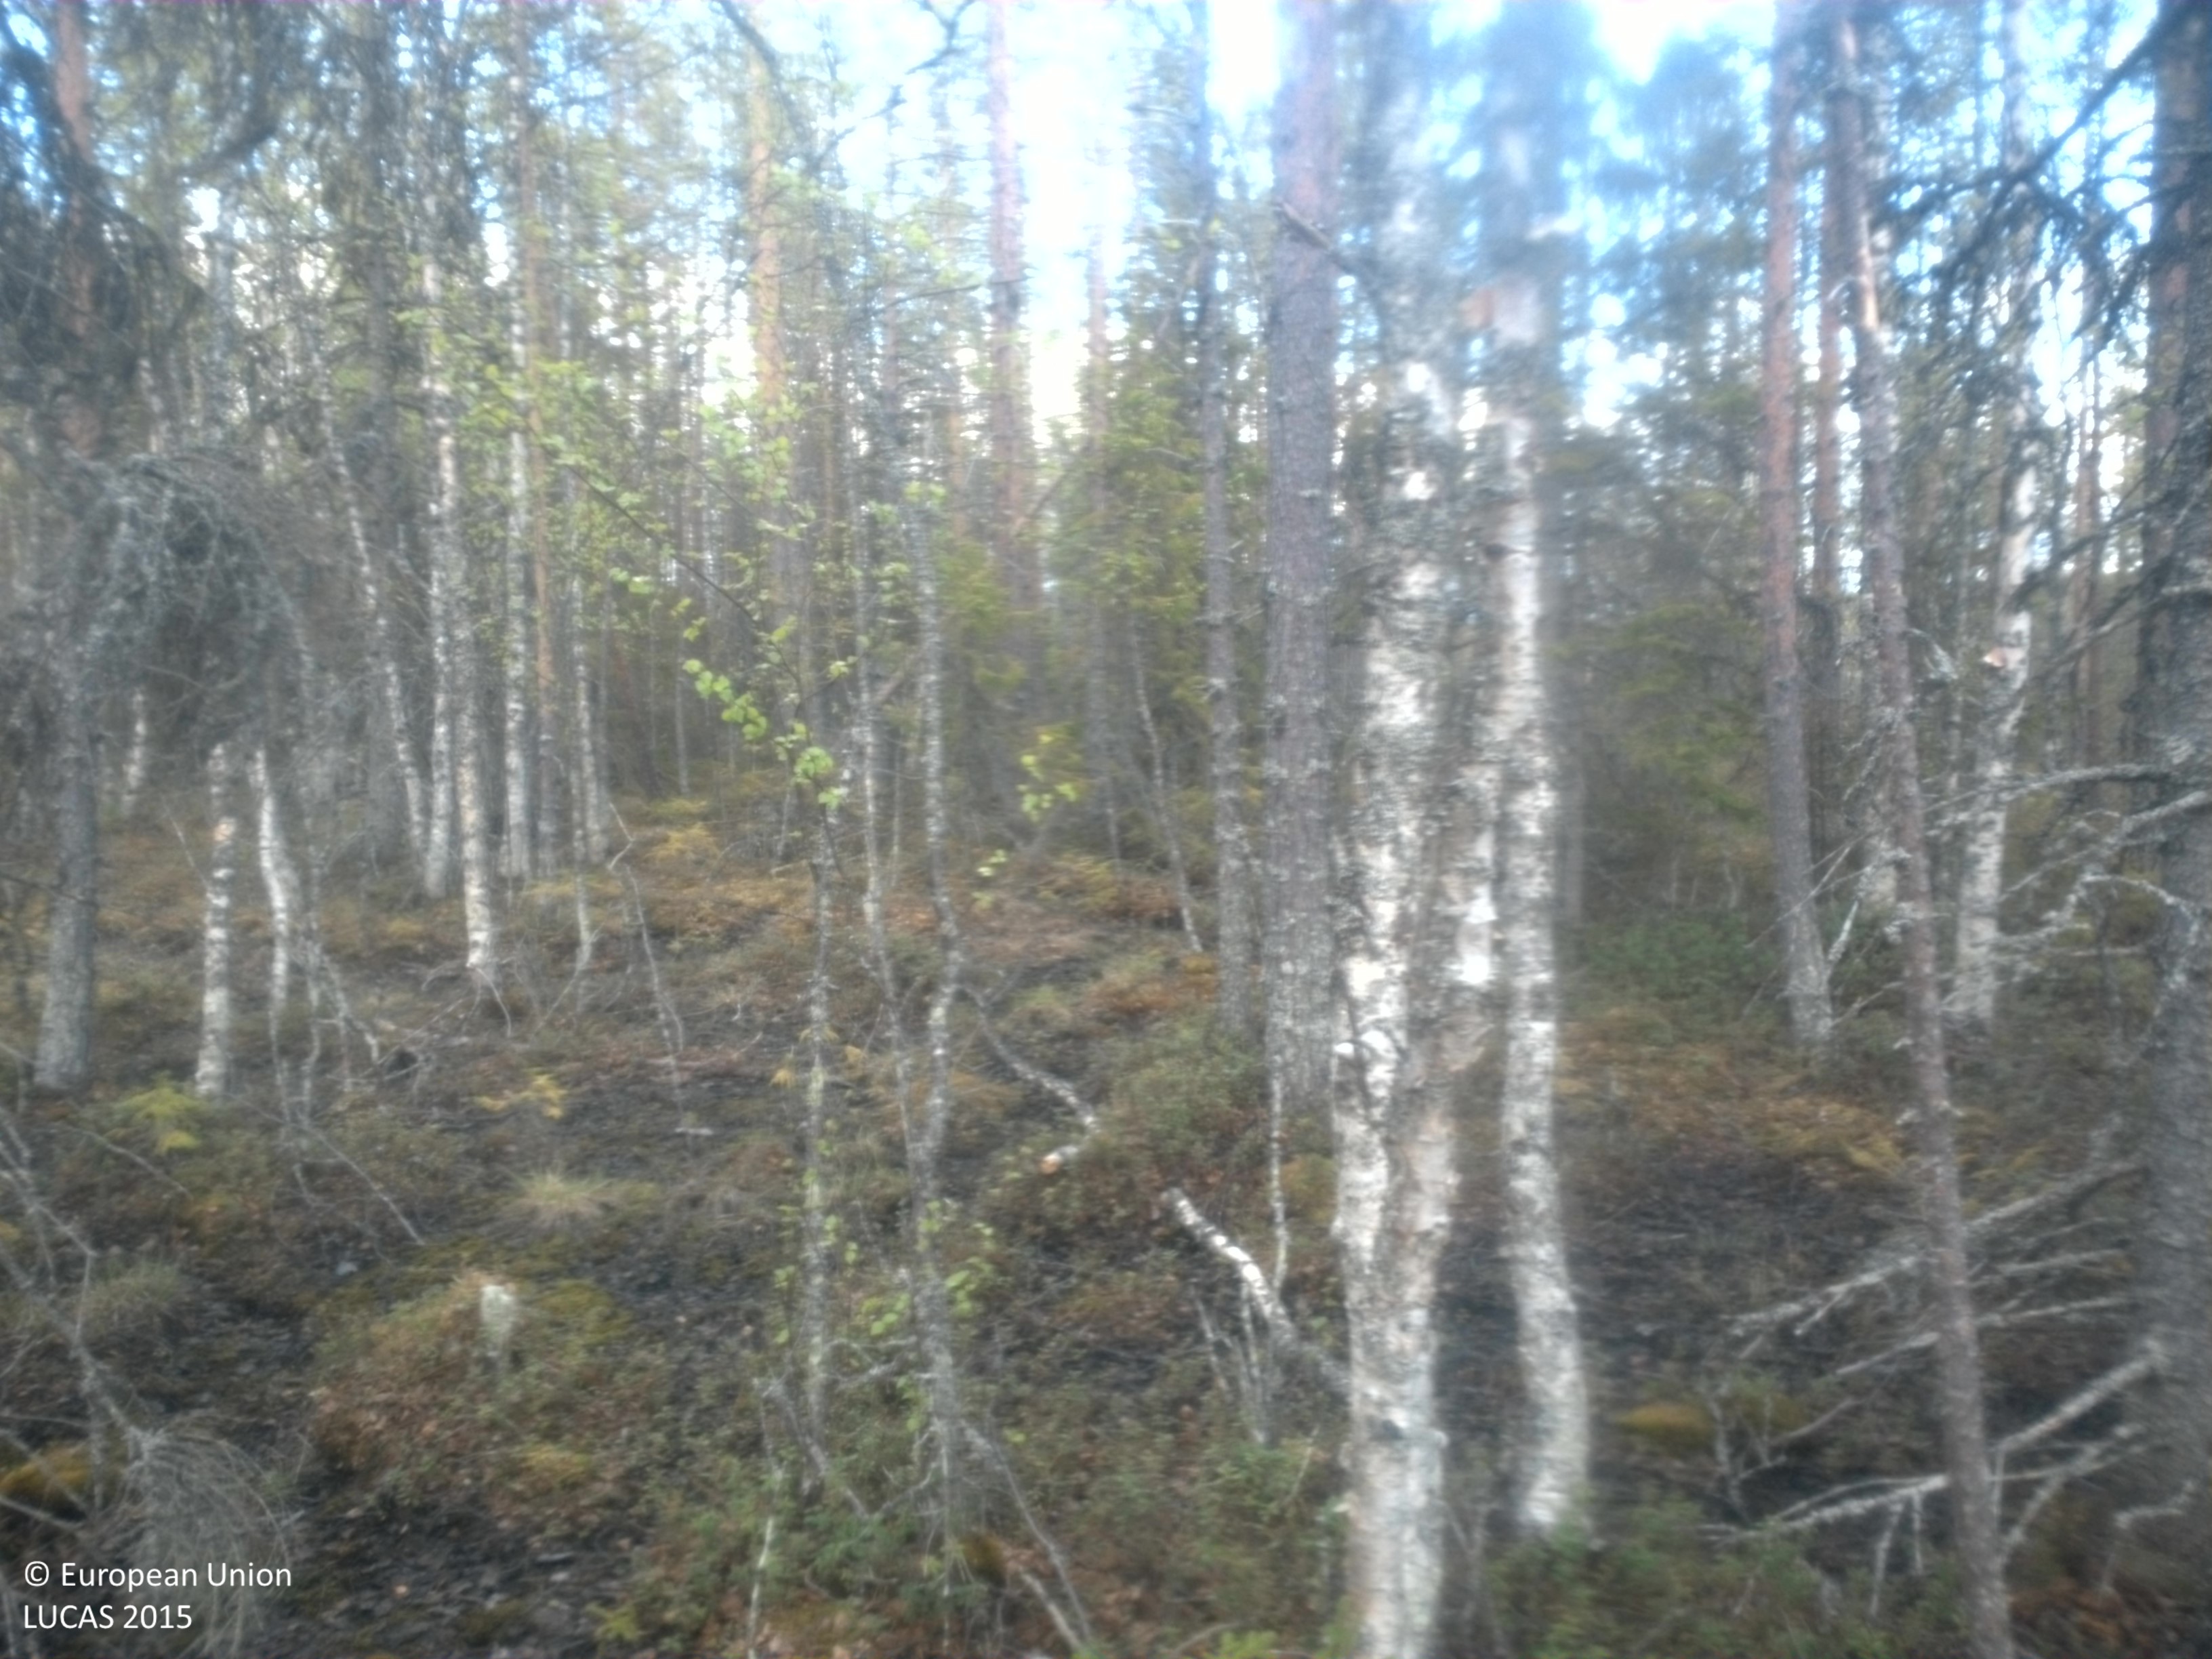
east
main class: Woodland
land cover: Pine dominated coniferous woodland
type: boreal forest
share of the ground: 50 - 75 %
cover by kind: coniferous forest trees 55 %, broadleaved forest trees 10 %, shrubs 10 %, herbaceous plants 10 %, lichens and mosses 10 %, unconsolidated bare surface 5 %
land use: Forestry
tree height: > 5 m
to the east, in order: Pine dominated coniferous woodland; Shrubland with sparse tree cover; Rivers and streams; Pine dominated mixed woodland; Shrubland with sparse tree cover
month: June
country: SE
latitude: 64.3945
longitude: 17.6620
